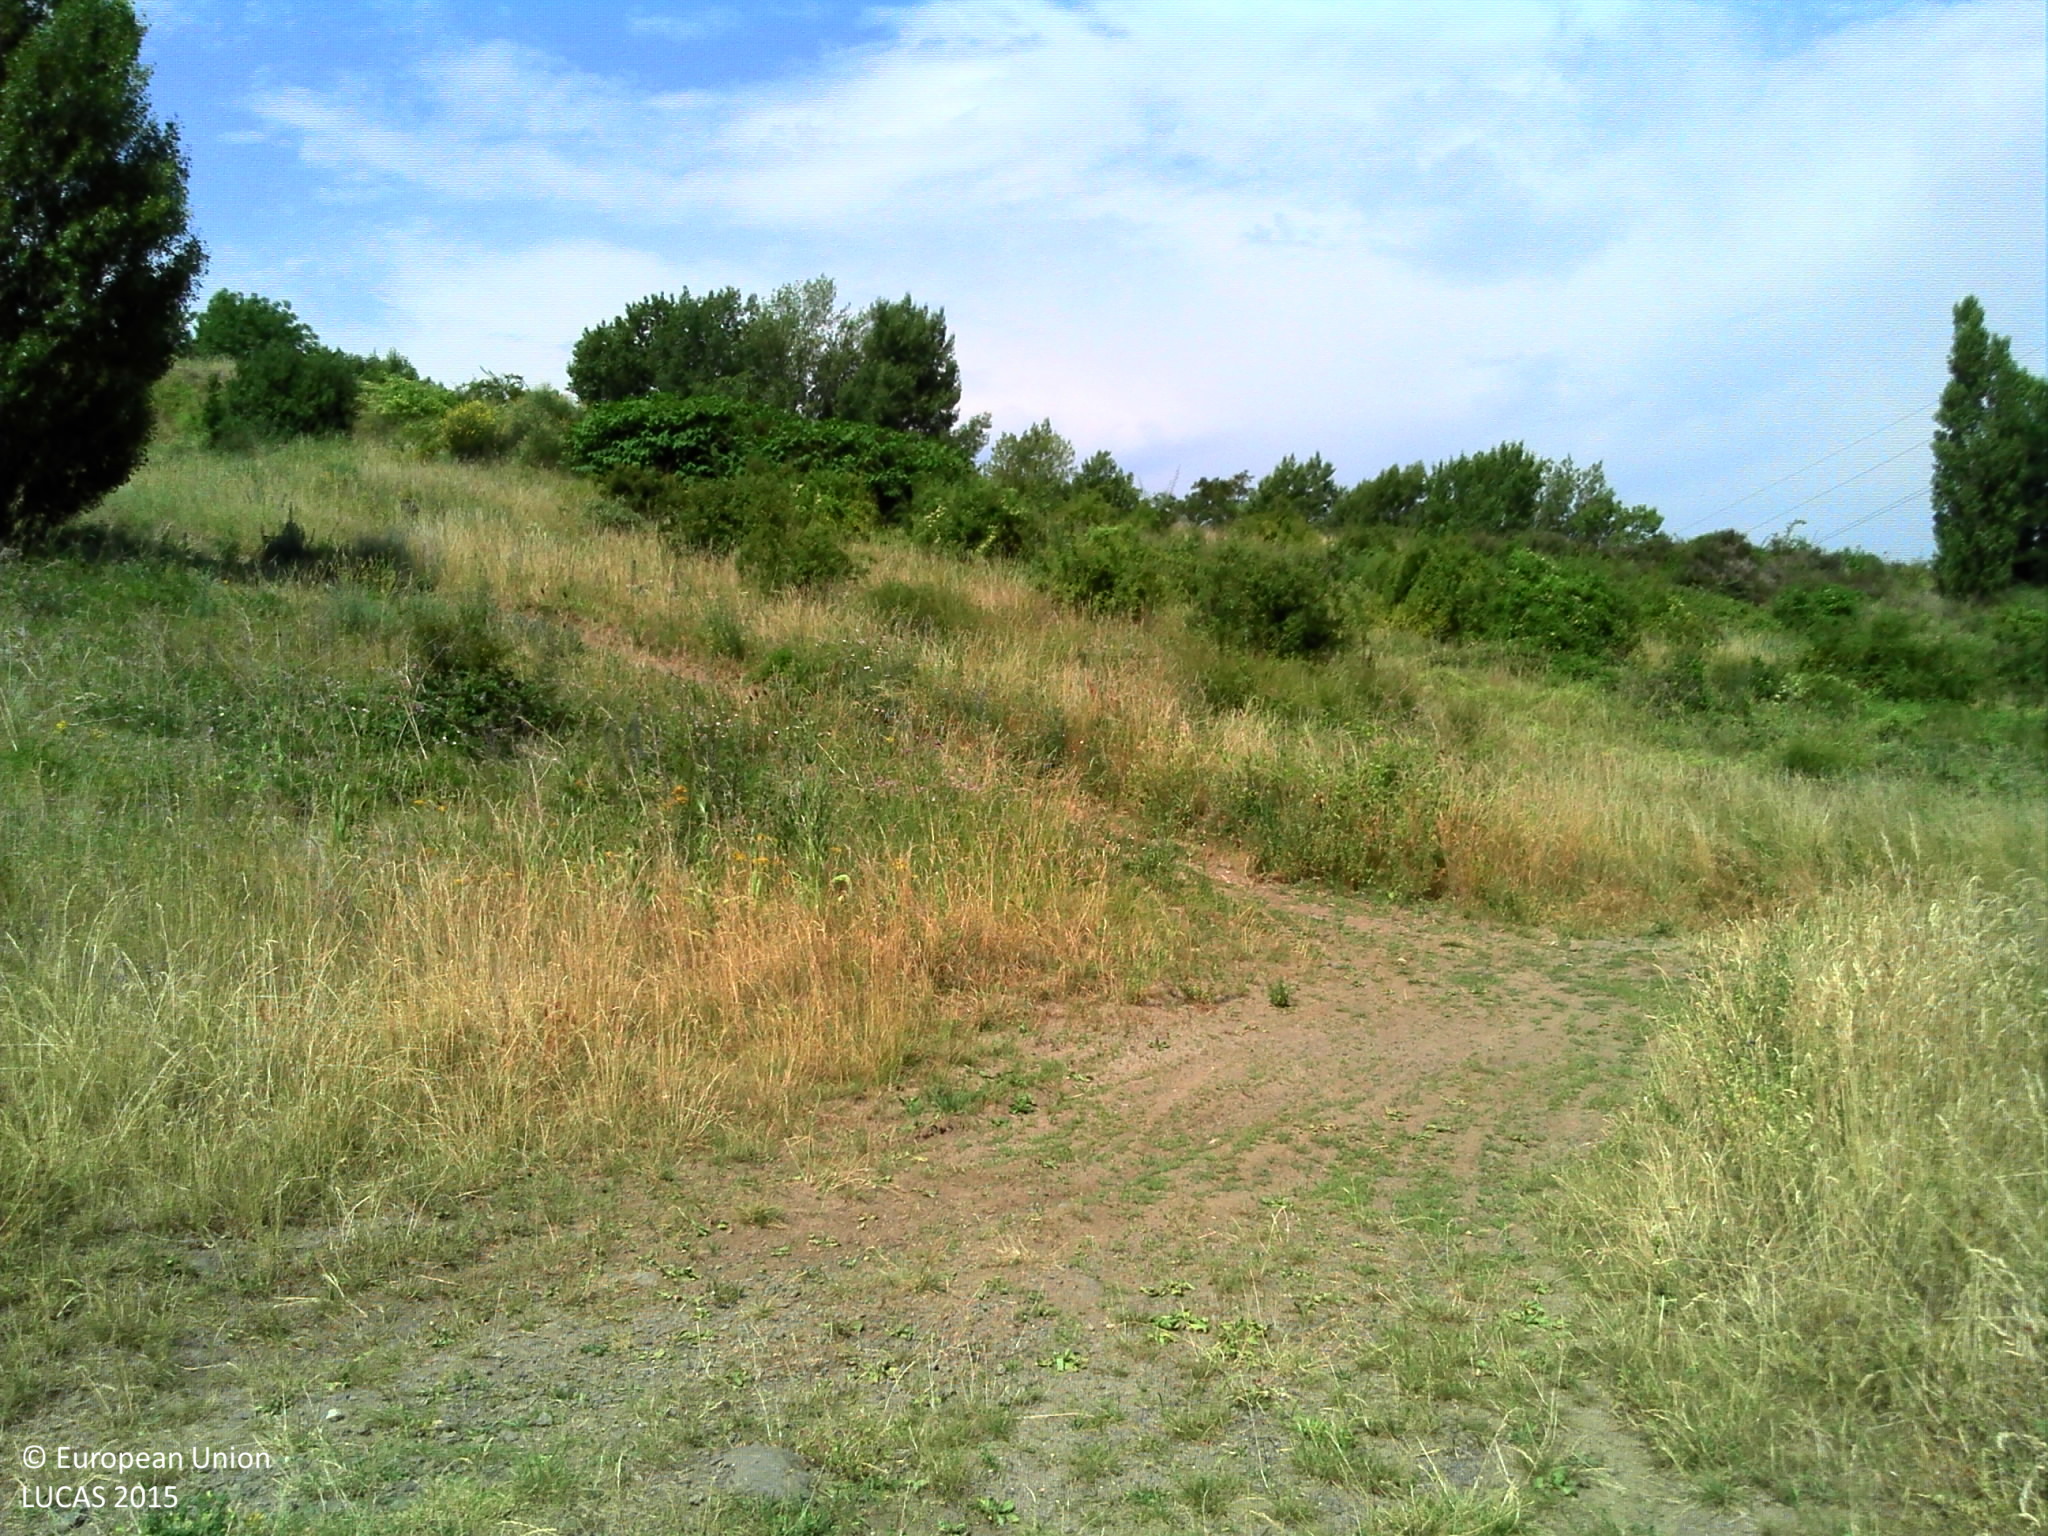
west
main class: Shrubland
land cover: Shrubland without tree cover
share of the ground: > 75 %
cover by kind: herbaceous plants 70 %, shrubs 30 %
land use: Sport
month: July
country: FR
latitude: 45.8006
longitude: 3.0646
